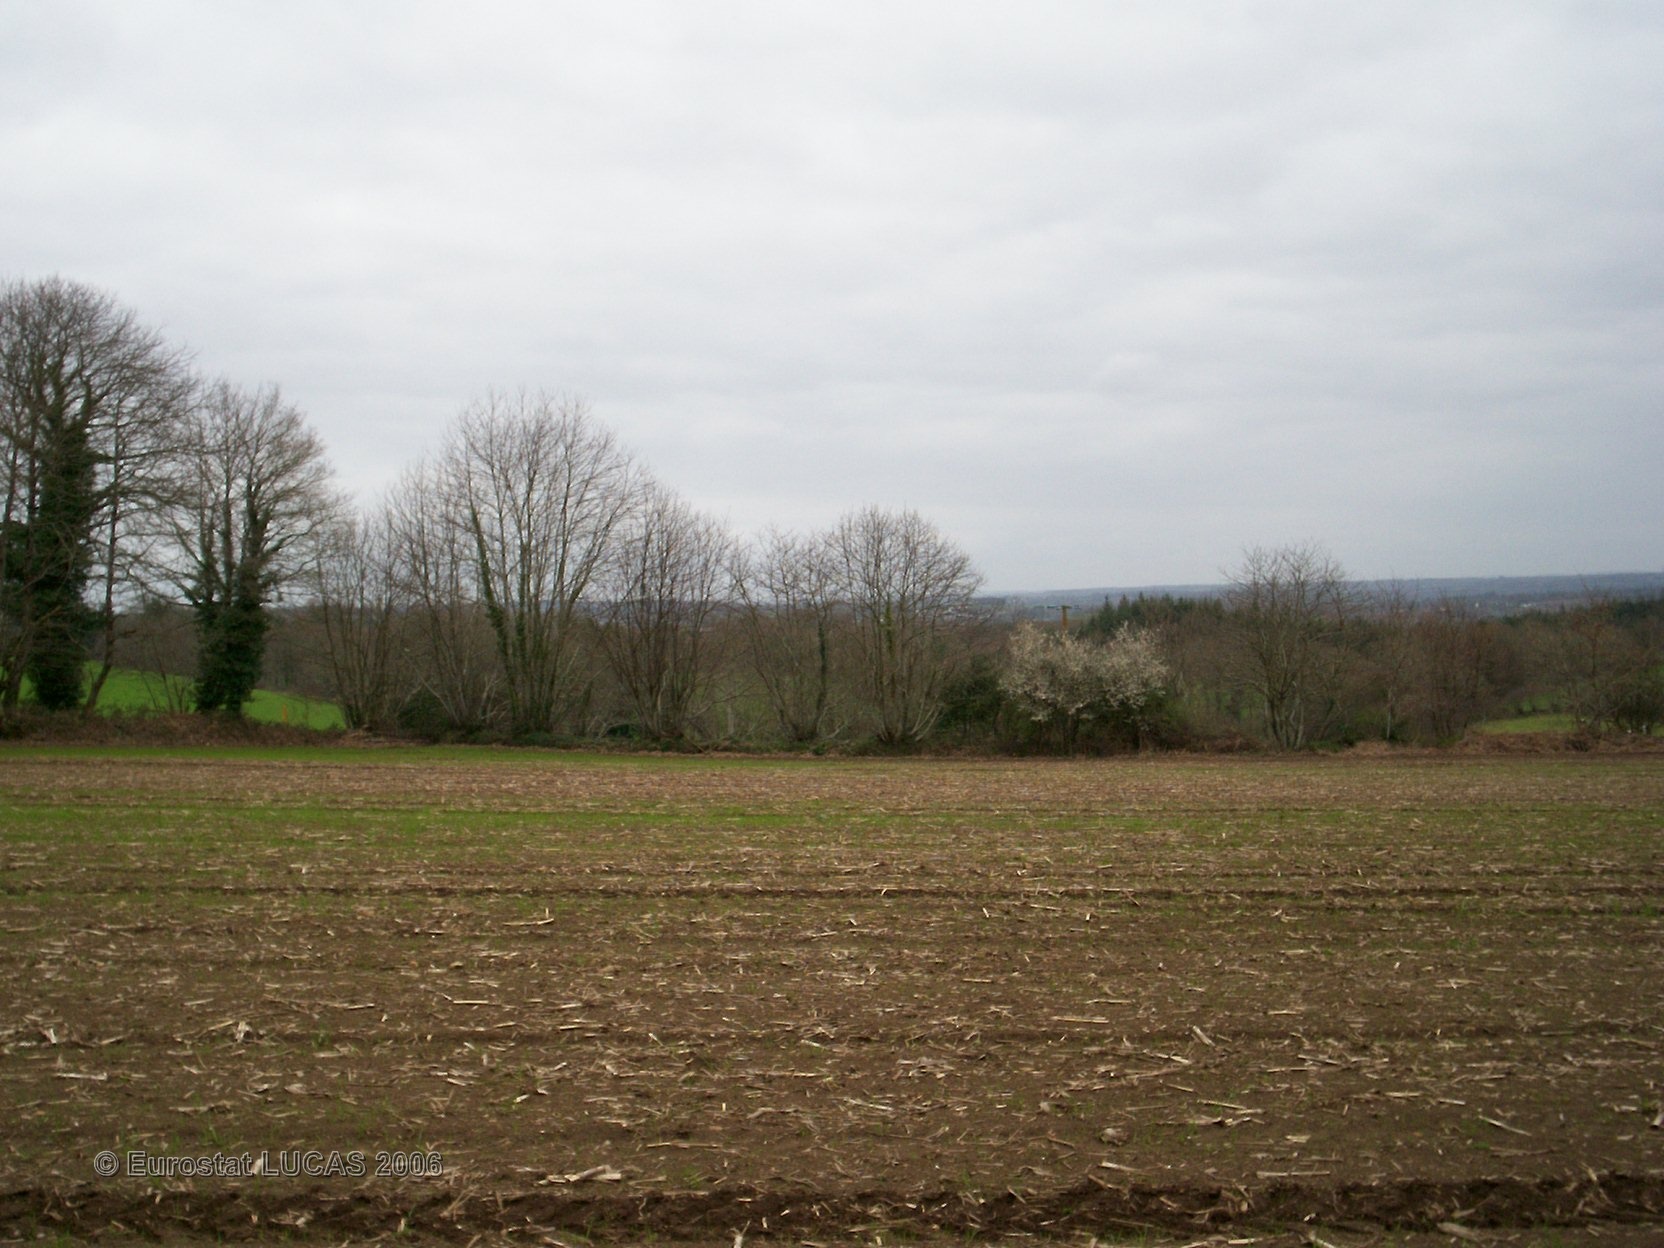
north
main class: Grassland
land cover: Grassland without tree/shrub cover
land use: Agriculture (excluding fallow land and kitchen gardens)
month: April
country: FR
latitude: 47.9674
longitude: -3.5383
